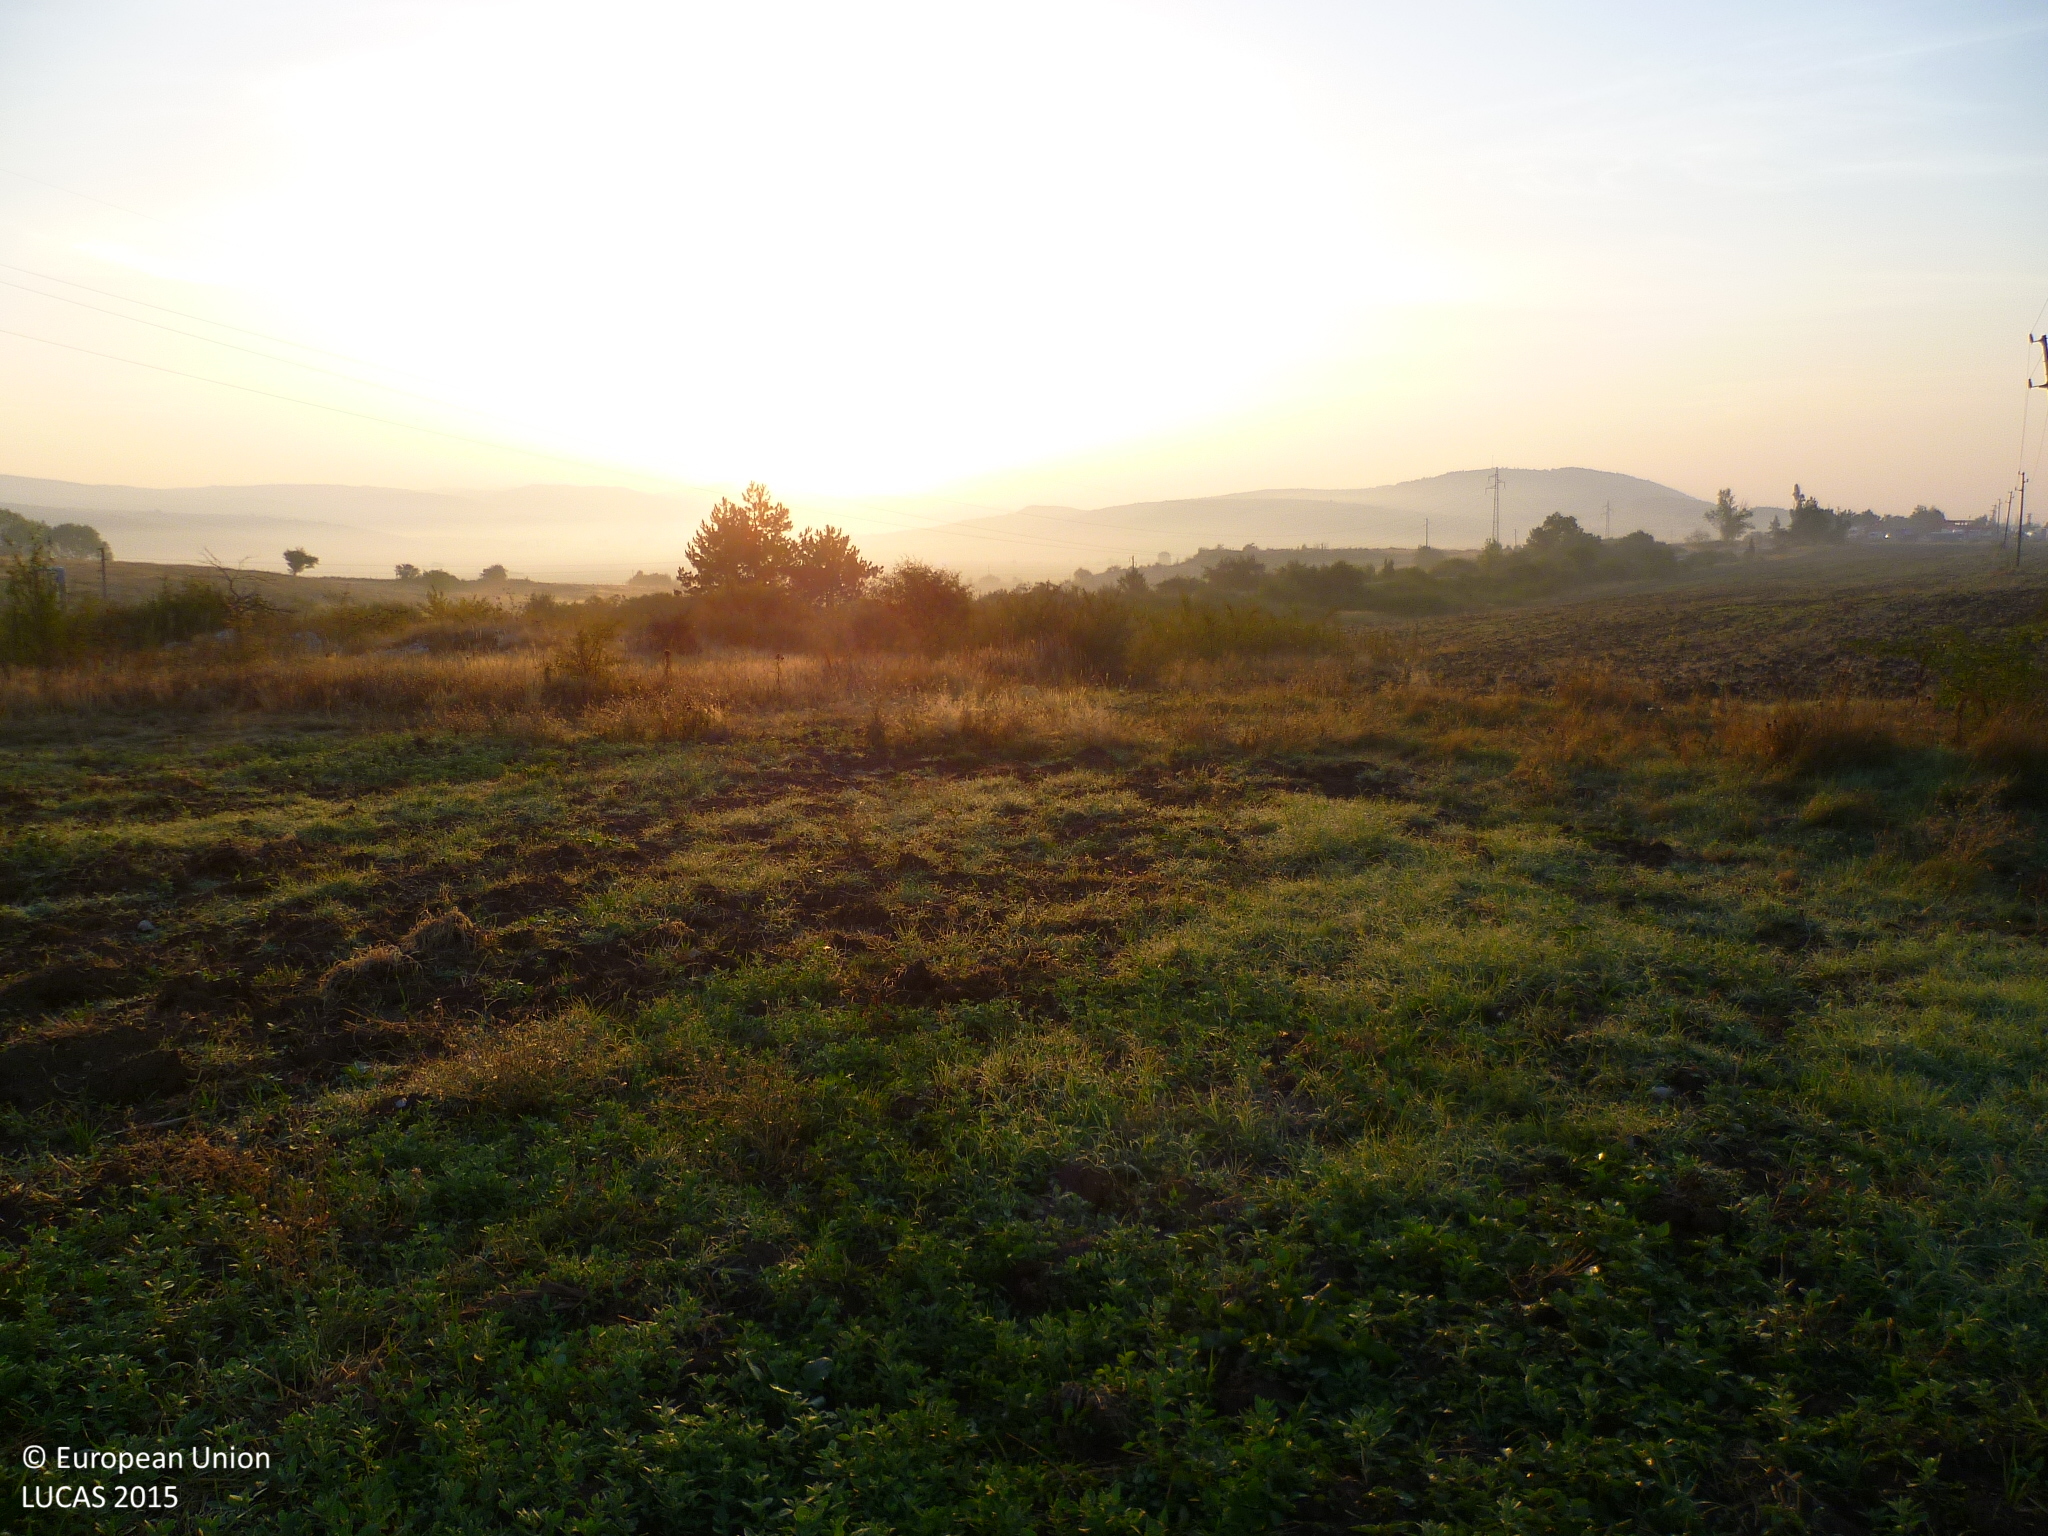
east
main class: Cropland
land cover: Rye
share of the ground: < 10 %
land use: Agriculture (excluding fallow land and kitchen gardens)
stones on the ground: < 10 %
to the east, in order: Rye; Grassland with sparse tree/shrub cover; Other bare soil; Grassland with sparse tree/shrub cover; Electric lines; Grassland with sparse tree/shrub cover; Ditches and canals; Paved roads, cycling and walking lanes; Shrubland with sparse tree cover; Common wheat; Electric lines; Common wheat
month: September
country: BG
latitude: 42.8692
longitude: 23.0191
